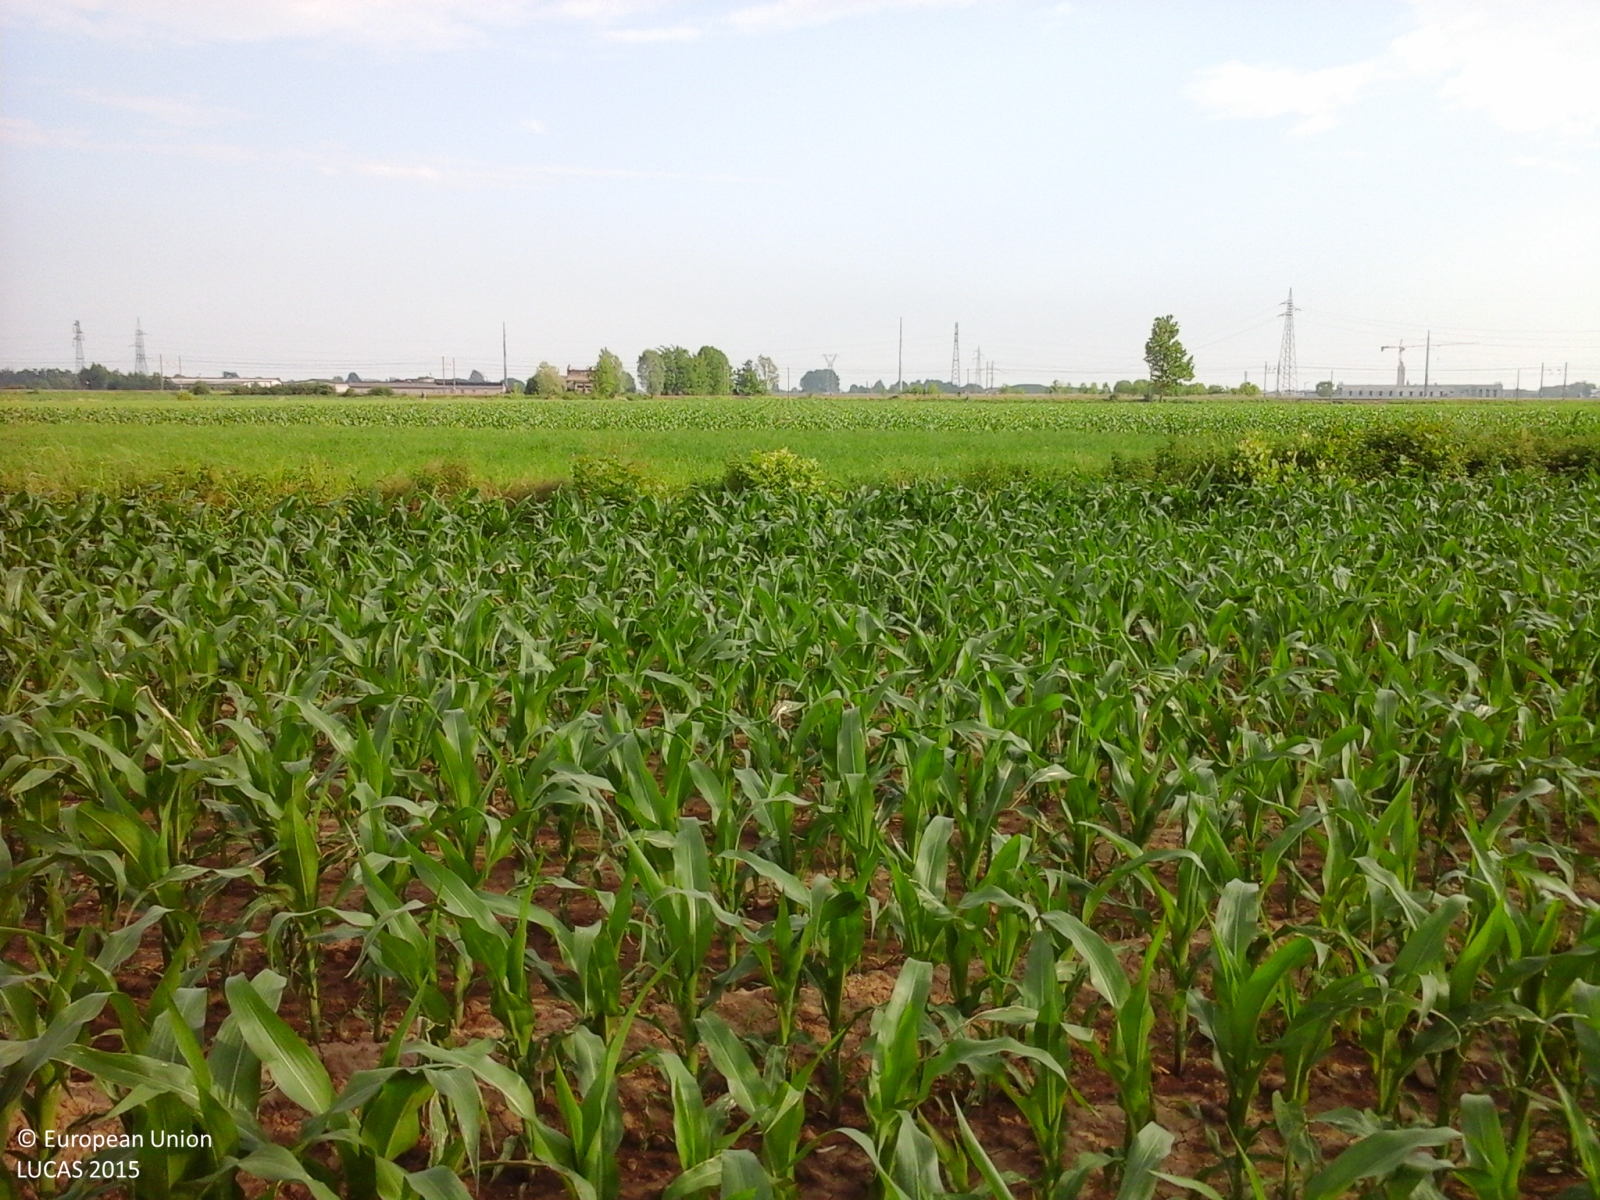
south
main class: Cropland
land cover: Maize
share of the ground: 25 - 50 %
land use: Agriculture (excluding fallow land and kitchen gardens)
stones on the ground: < 10 %
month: May
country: IT
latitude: 45.5219
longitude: 9.6549
